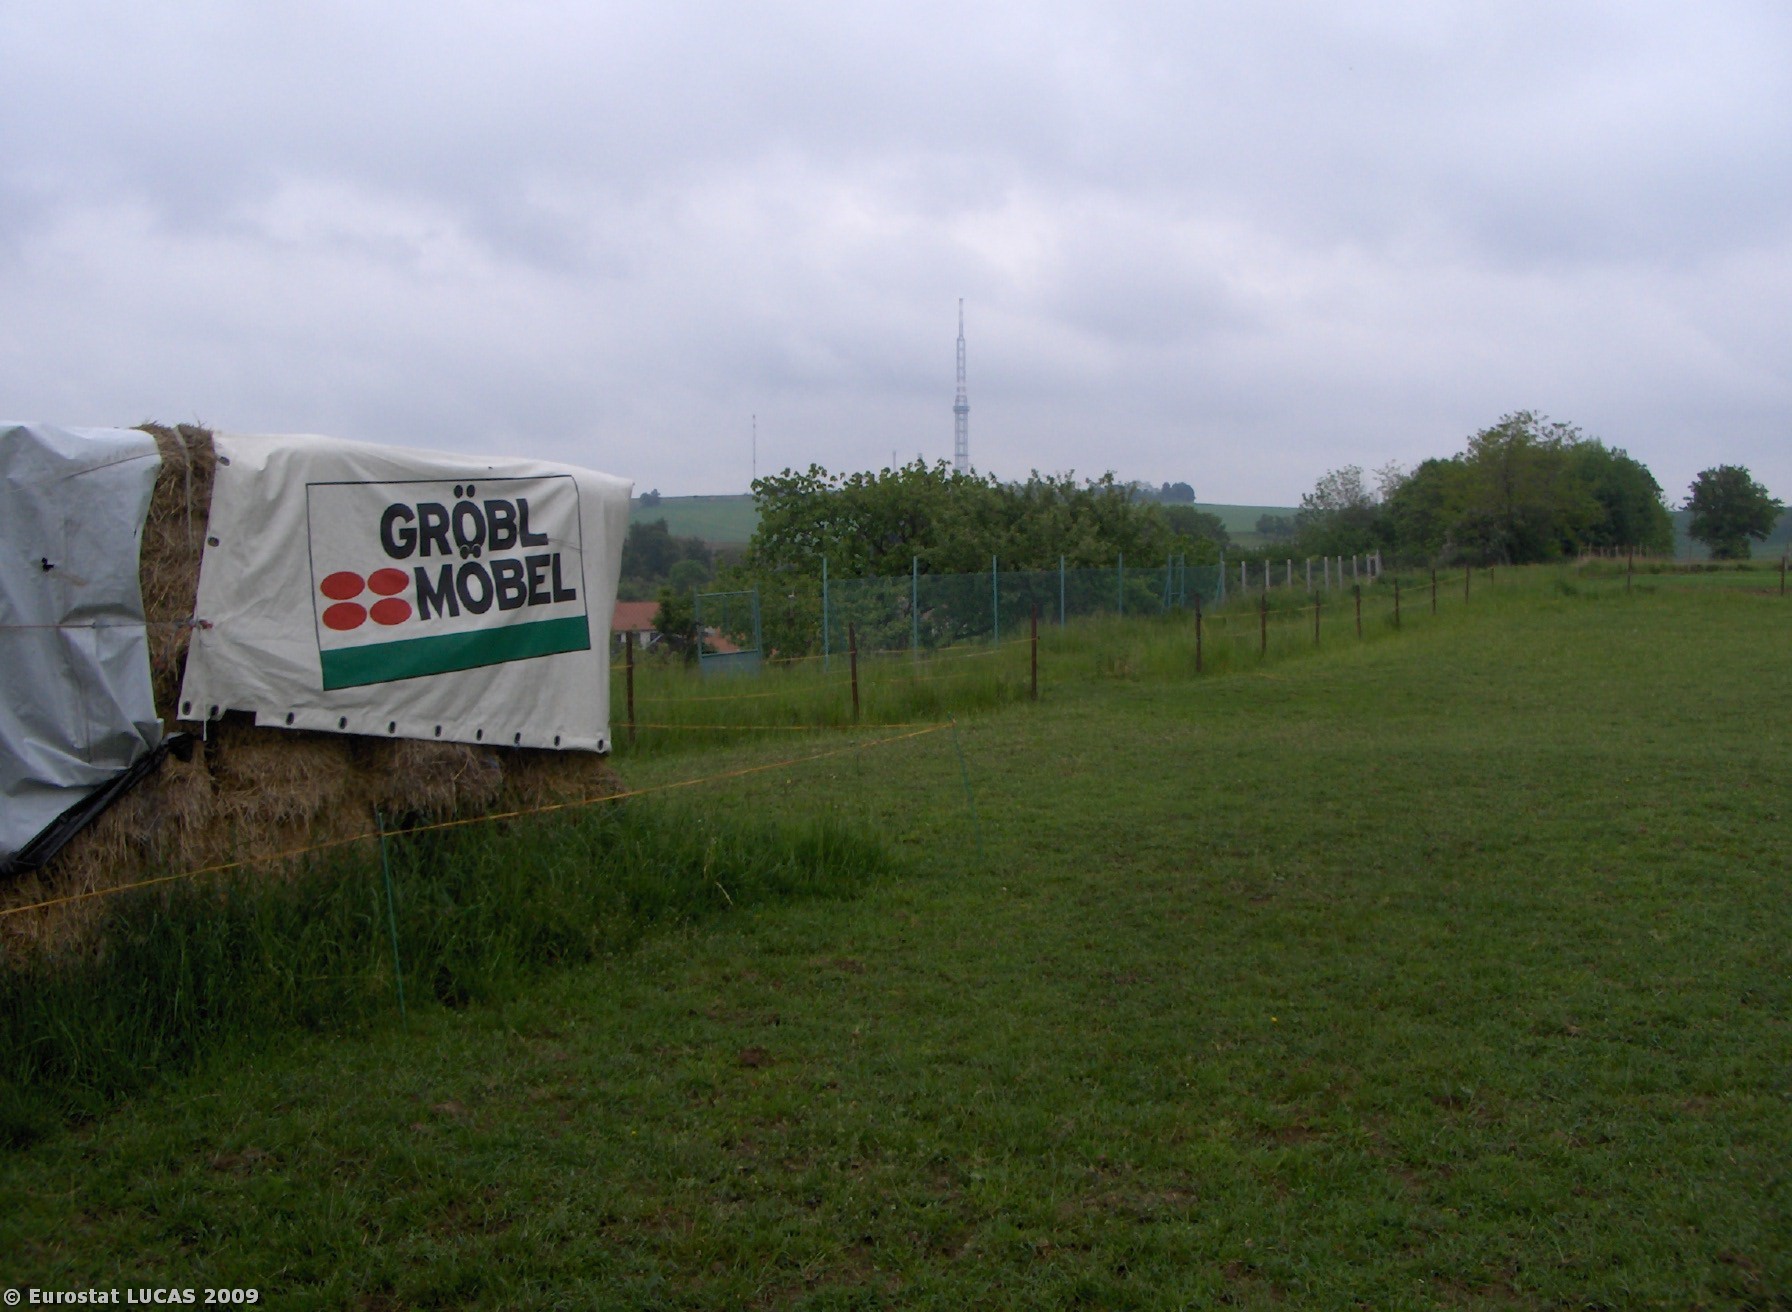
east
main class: Grassland
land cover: Grassland with sparse tree/shrub cover
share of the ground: > 75 %
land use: Agriculture (excluding fallow land and kitchen gardens)
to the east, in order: Grassland with sparse tree/shrub cover; Fences; Grassland without tree/shrub cover; Fences; Grass margins; Tracks; Grass margins; Fences; Apple fruit; Grassland with sparse tree/shrub cover; Grassland without tree/shrub cover; Artificial constructions in urban areas
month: May
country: CZ
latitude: 49.3848
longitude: 17.1042
